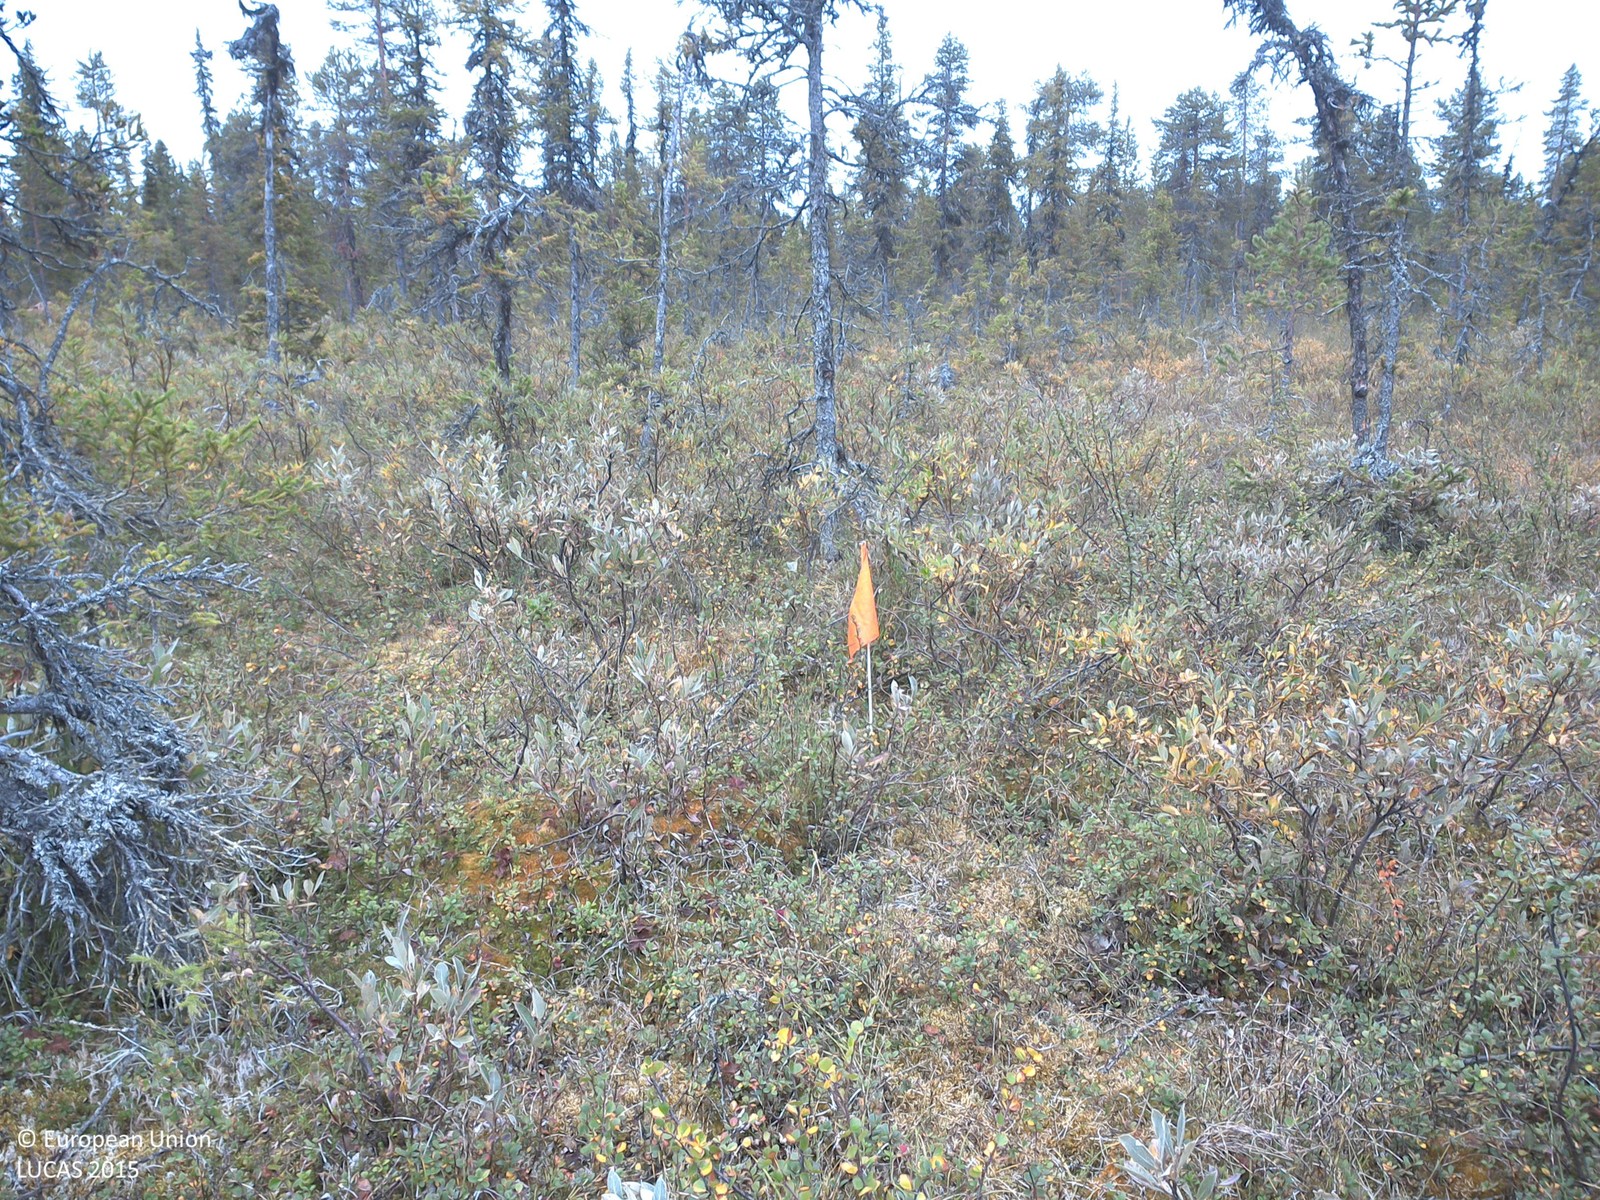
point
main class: Woodland
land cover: Spruce dominated coniferous woodland
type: boreal forest
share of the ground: 10 - 25 %
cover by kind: shrubs 65 %, lichens and mosses 20 %, coniferous forest trees 15 %
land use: Semi-natural and natural areas not in use
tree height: > 5 m
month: August
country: SE
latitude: 67.8384
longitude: 21.3227
